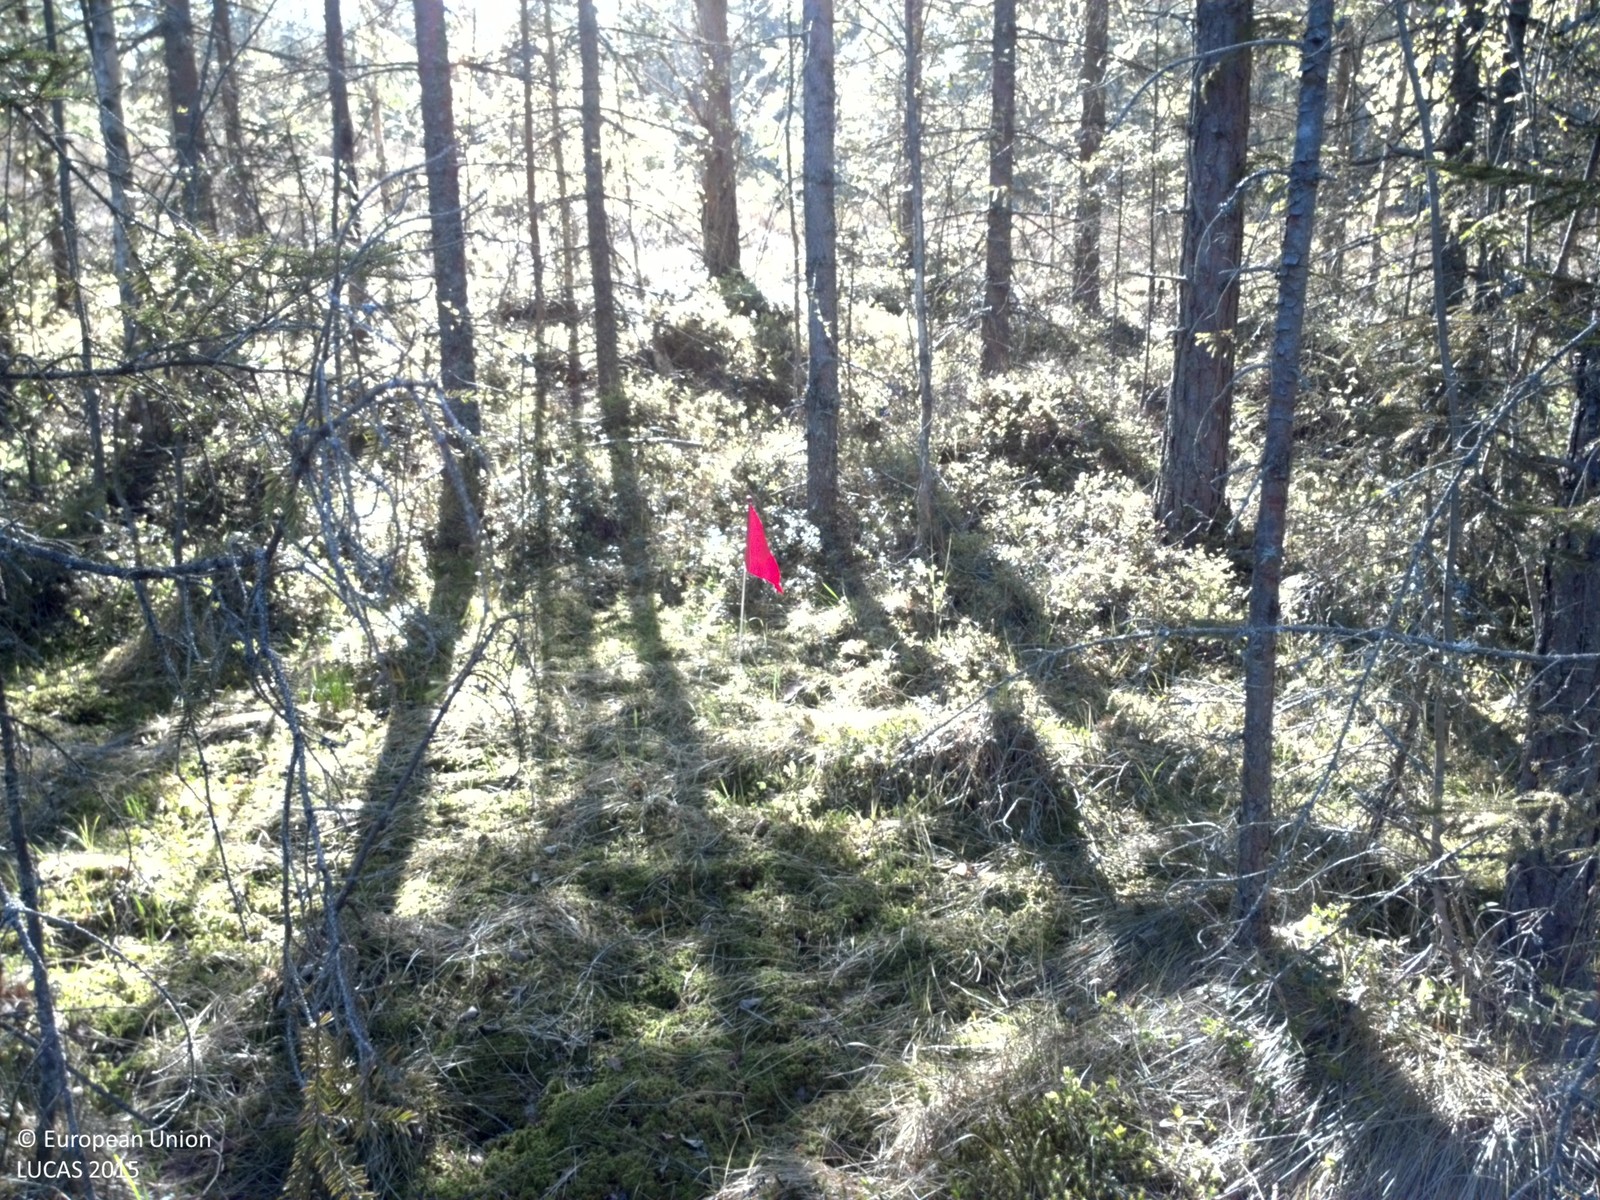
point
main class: Woodland
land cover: Spruce dominated coniferous woodland
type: boreal forest
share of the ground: > 75 %
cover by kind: coniferous forest trees 80 %, lichens and mosses 10 %, broadleaved forest trees 5 %, shrubs 5 %
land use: Forestry
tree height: > 5 m
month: May
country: SE
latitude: 59.4943
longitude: 12.3782
